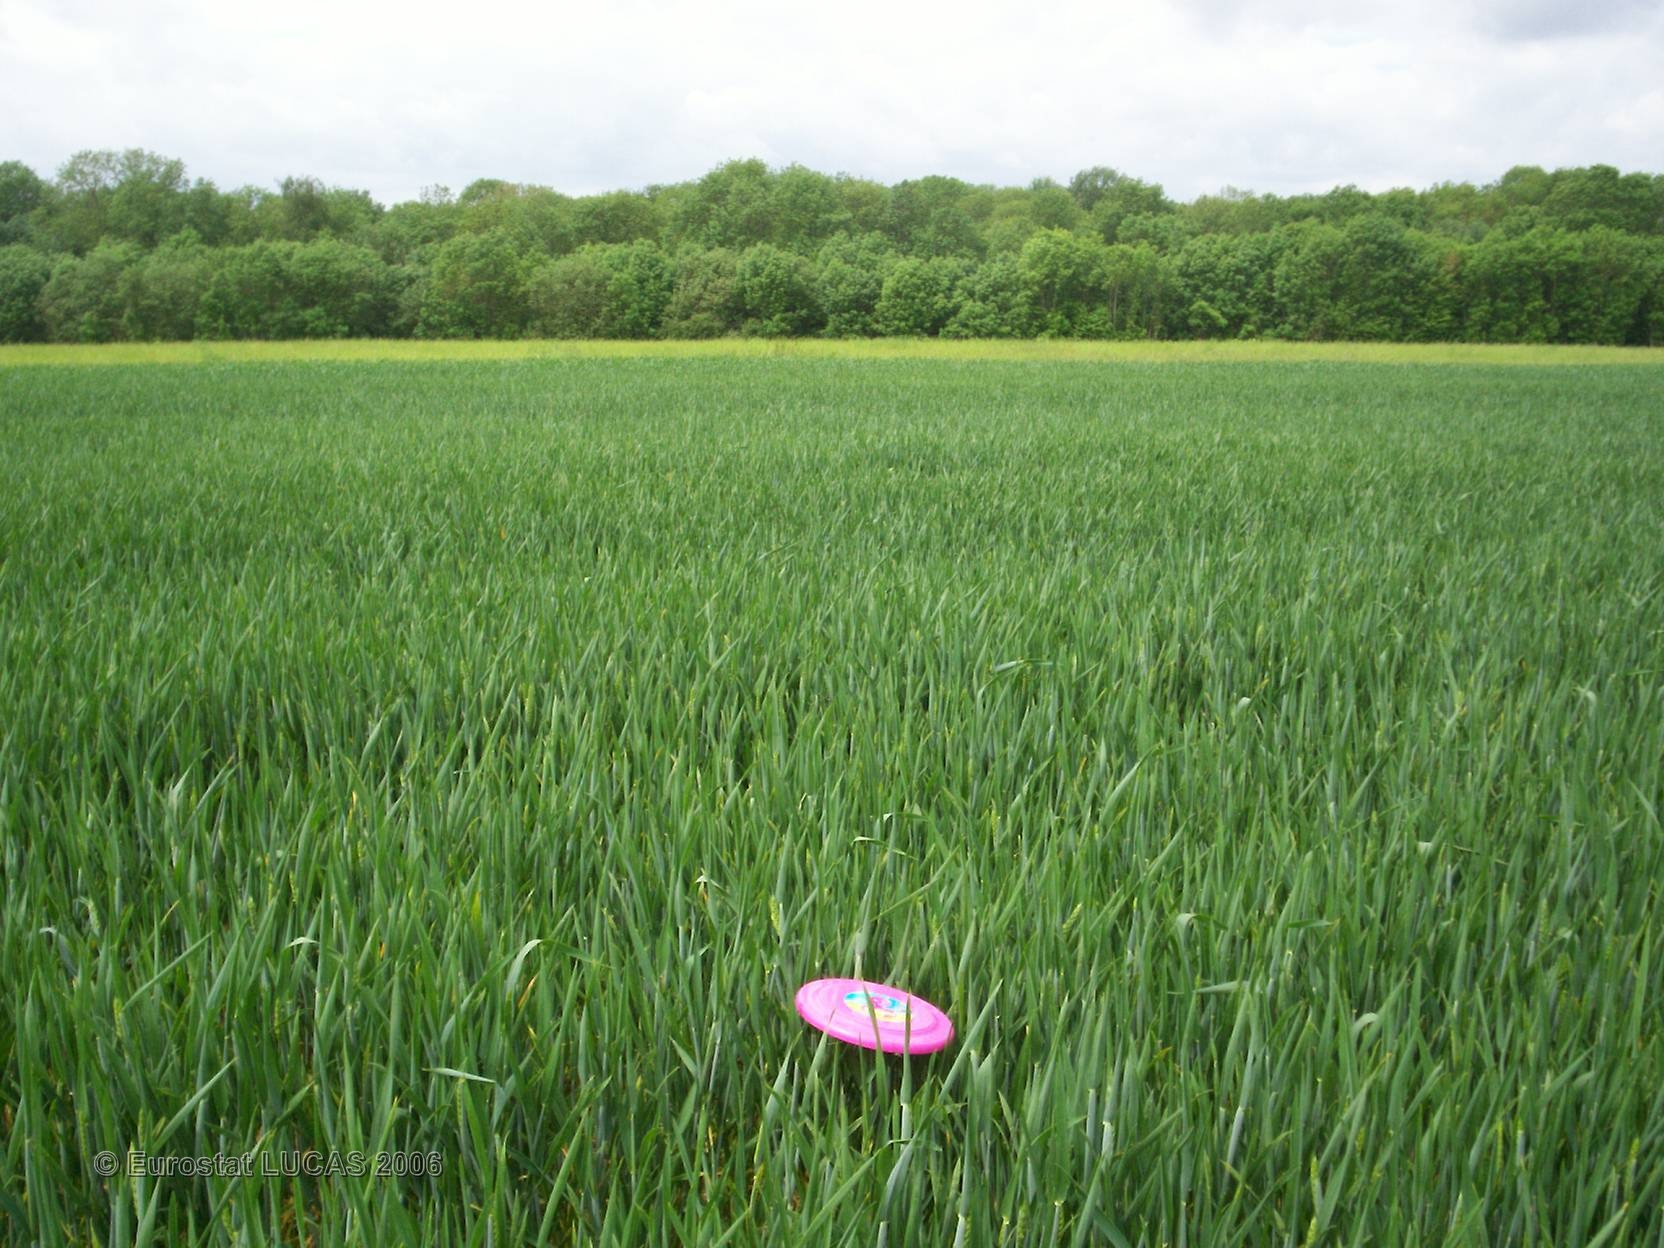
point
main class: Cropland
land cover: Common wheat
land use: Agriculture (excluding fallow land and kitchen gardens)
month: May
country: FR
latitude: 48.6748
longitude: 2.8066
